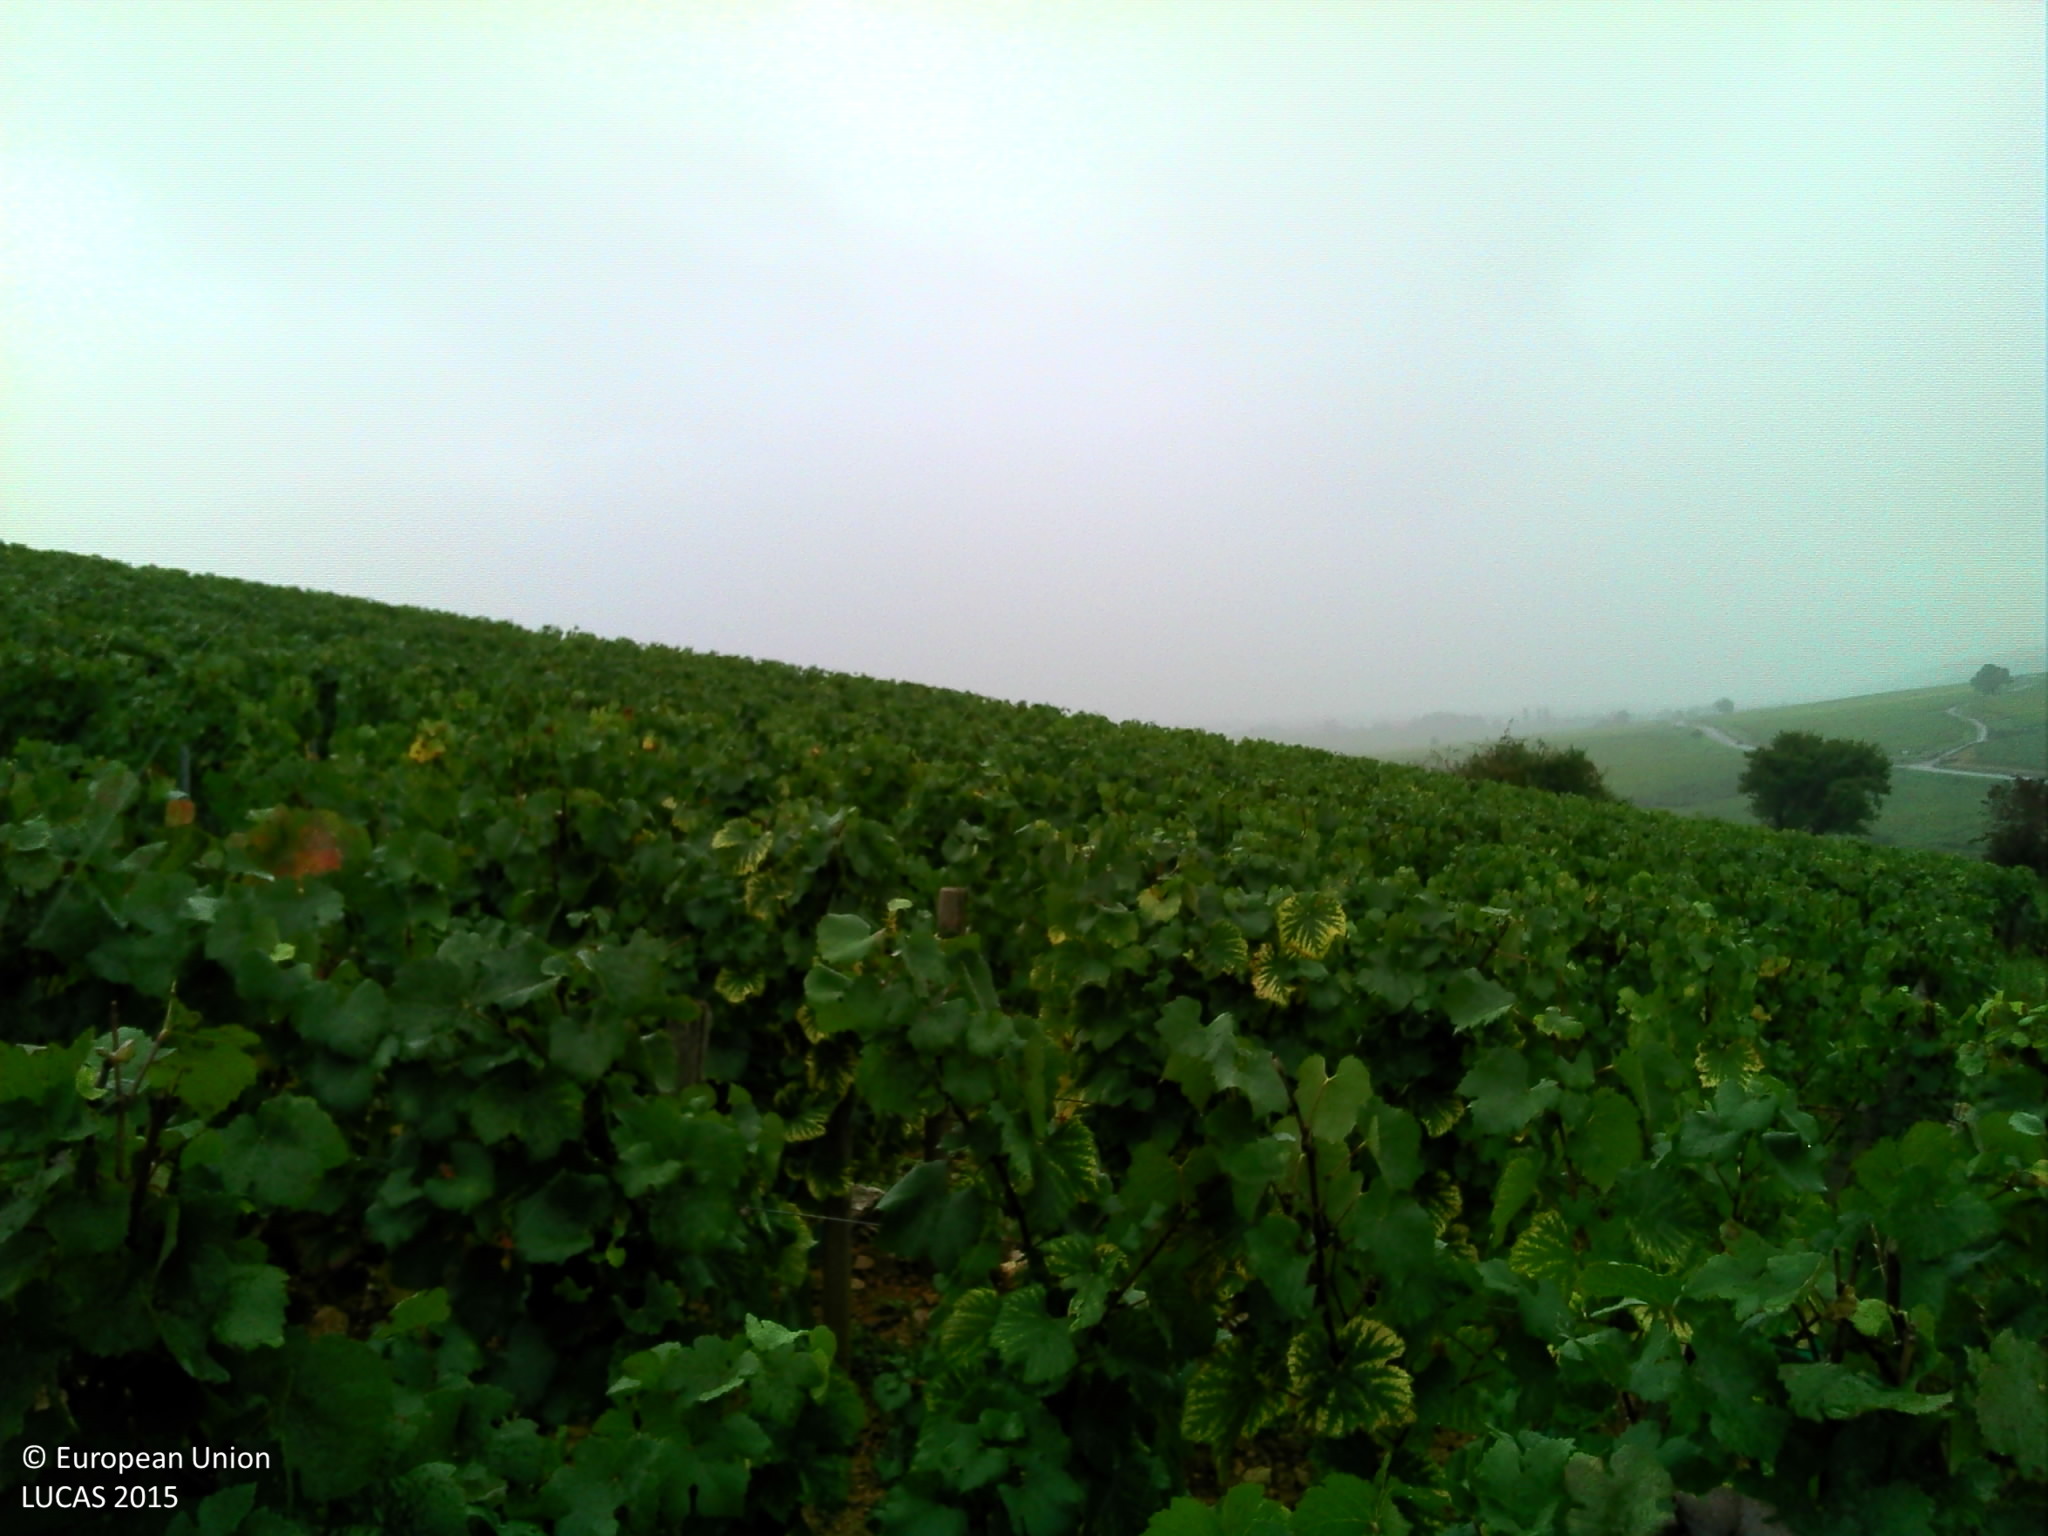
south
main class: Cropland
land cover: Vineyards
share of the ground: 10 - 25 %
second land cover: Other bare soil
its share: > 75 %
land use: Agriculture (excluding fallow land and kitchen gardens)
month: September
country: FR
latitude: 47.0753
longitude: 4.8514
